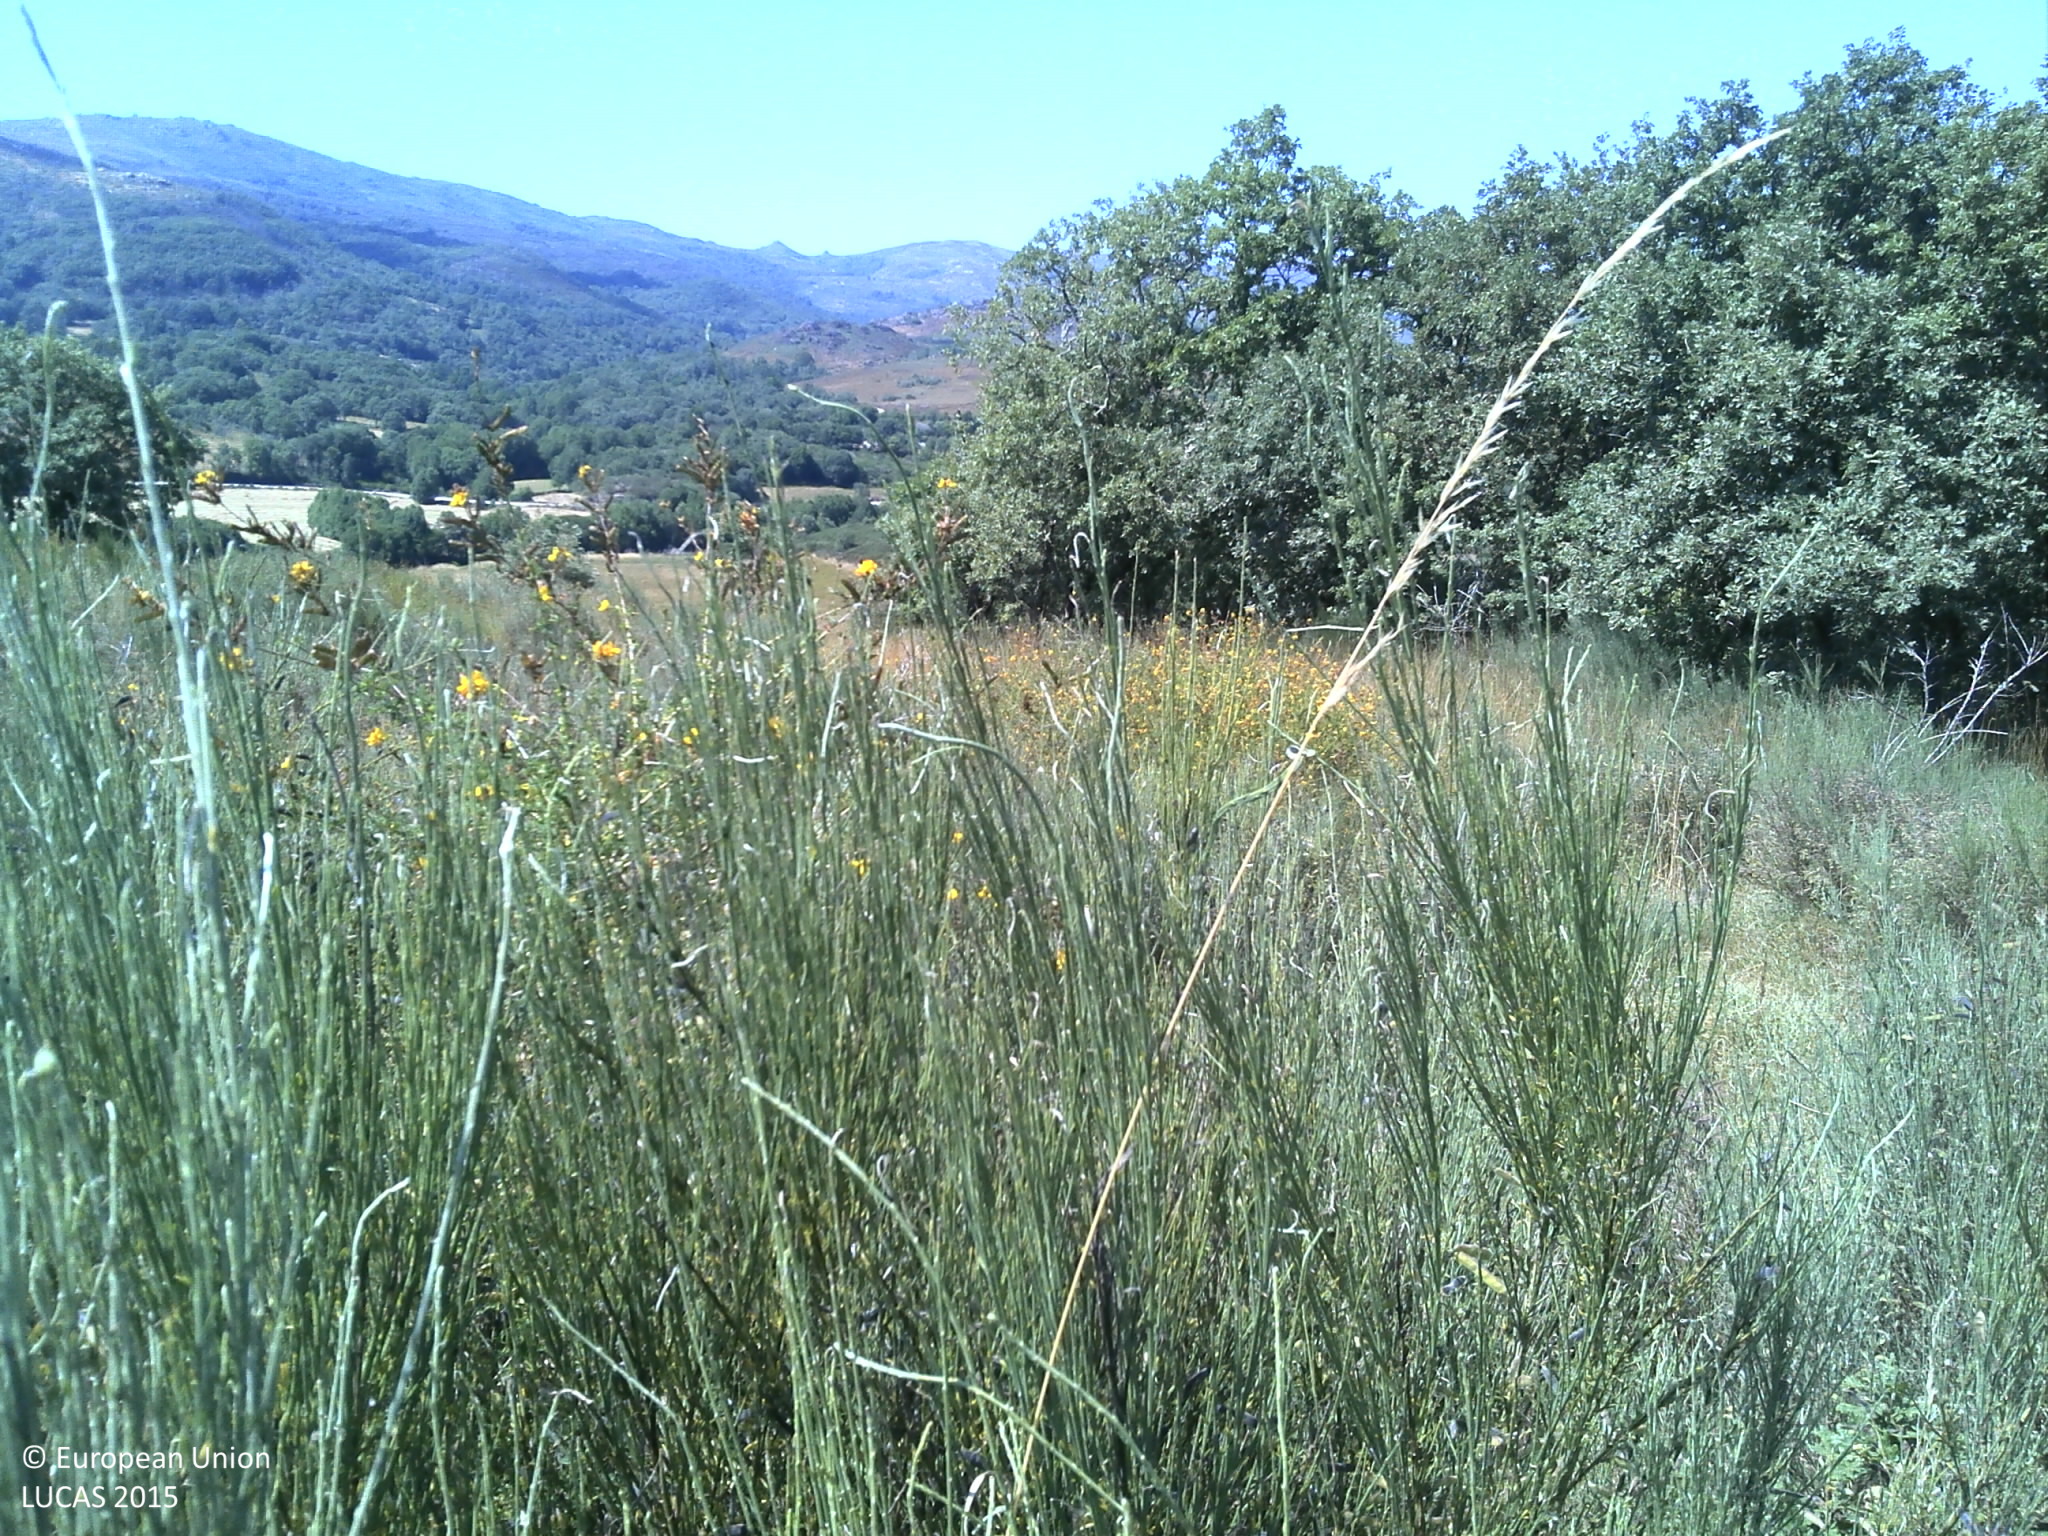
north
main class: Shrubland
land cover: Shrubland without tree cover
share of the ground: > 75 %
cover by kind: shrubs 90 %, herbaceous plants 5 %, unconsolidated bare surface 5 %
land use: Agriculture (excluding fallow land and kitchen gardens)
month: July
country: PT
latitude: 41.8101
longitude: -7.8480
